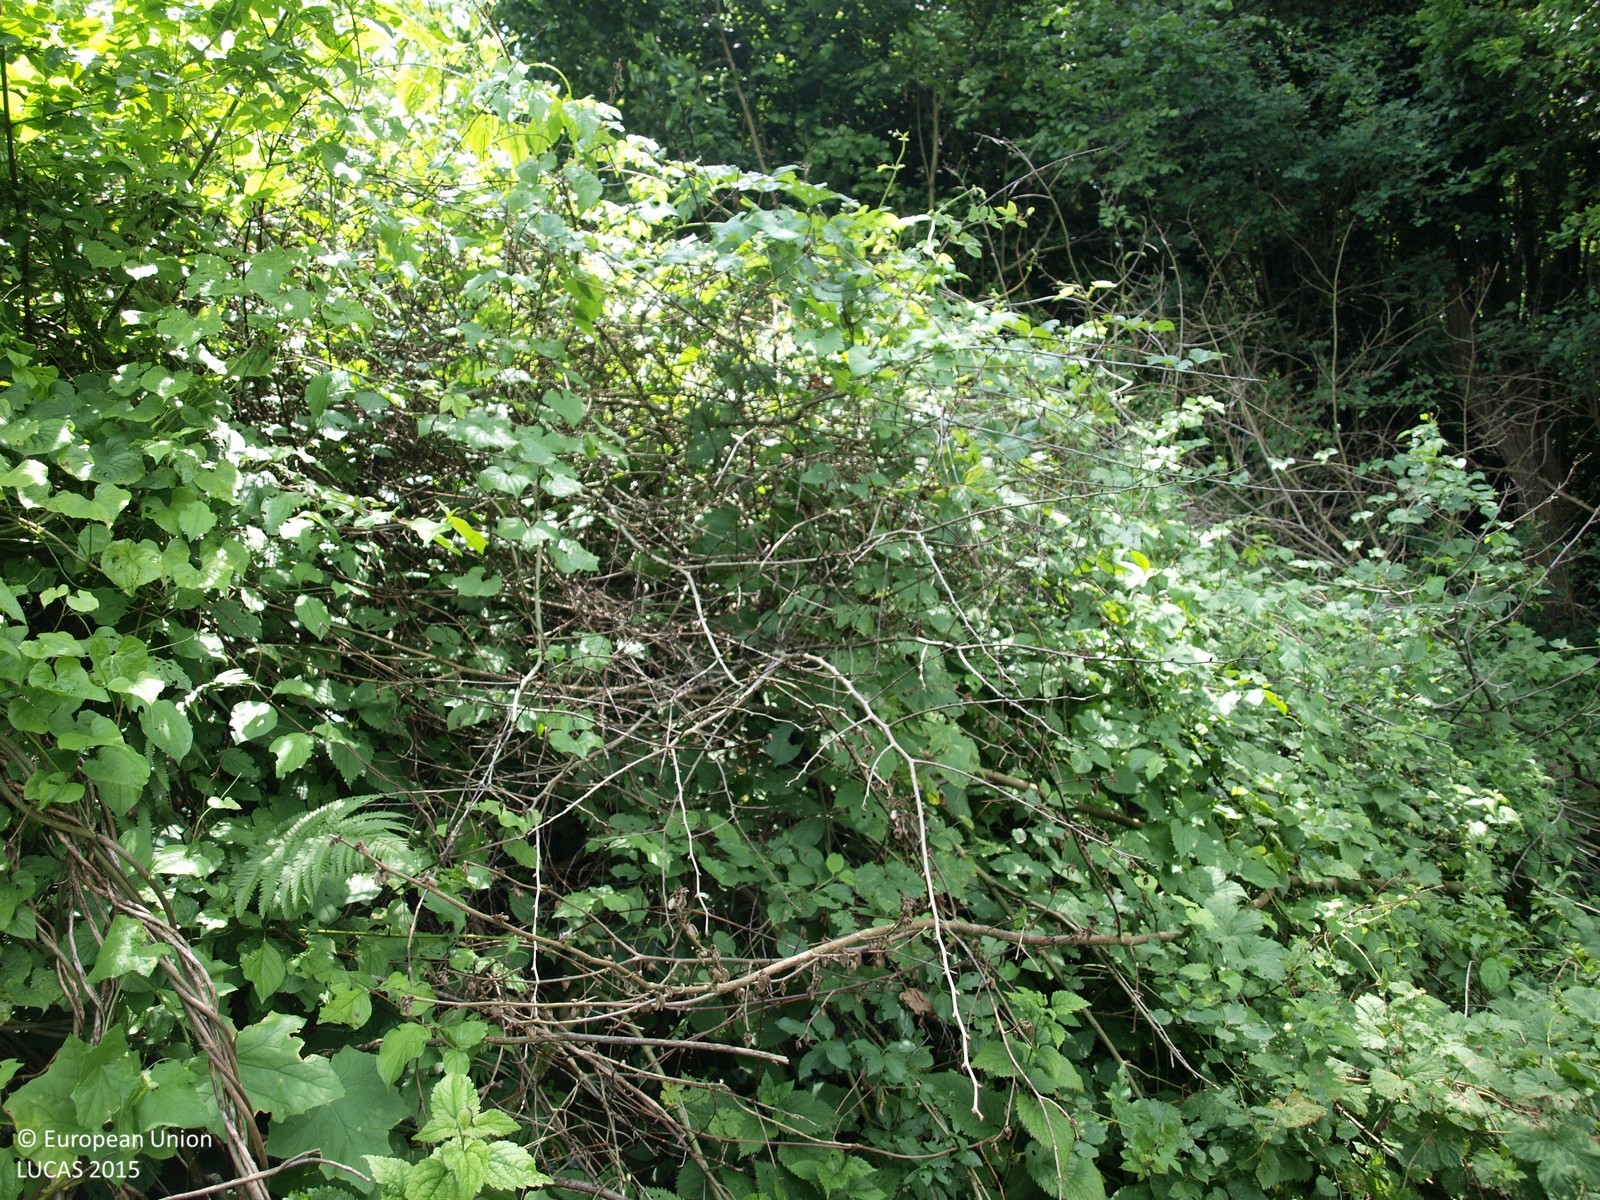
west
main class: Artificial land
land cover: Other artificial areas
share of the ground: 25 - 50 %
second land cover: Shrubland without tree cover
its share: > 75 %
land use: Electricity, gas and thermal power distribution
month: June
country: HR
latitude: 46.1253
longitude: 15.7314
